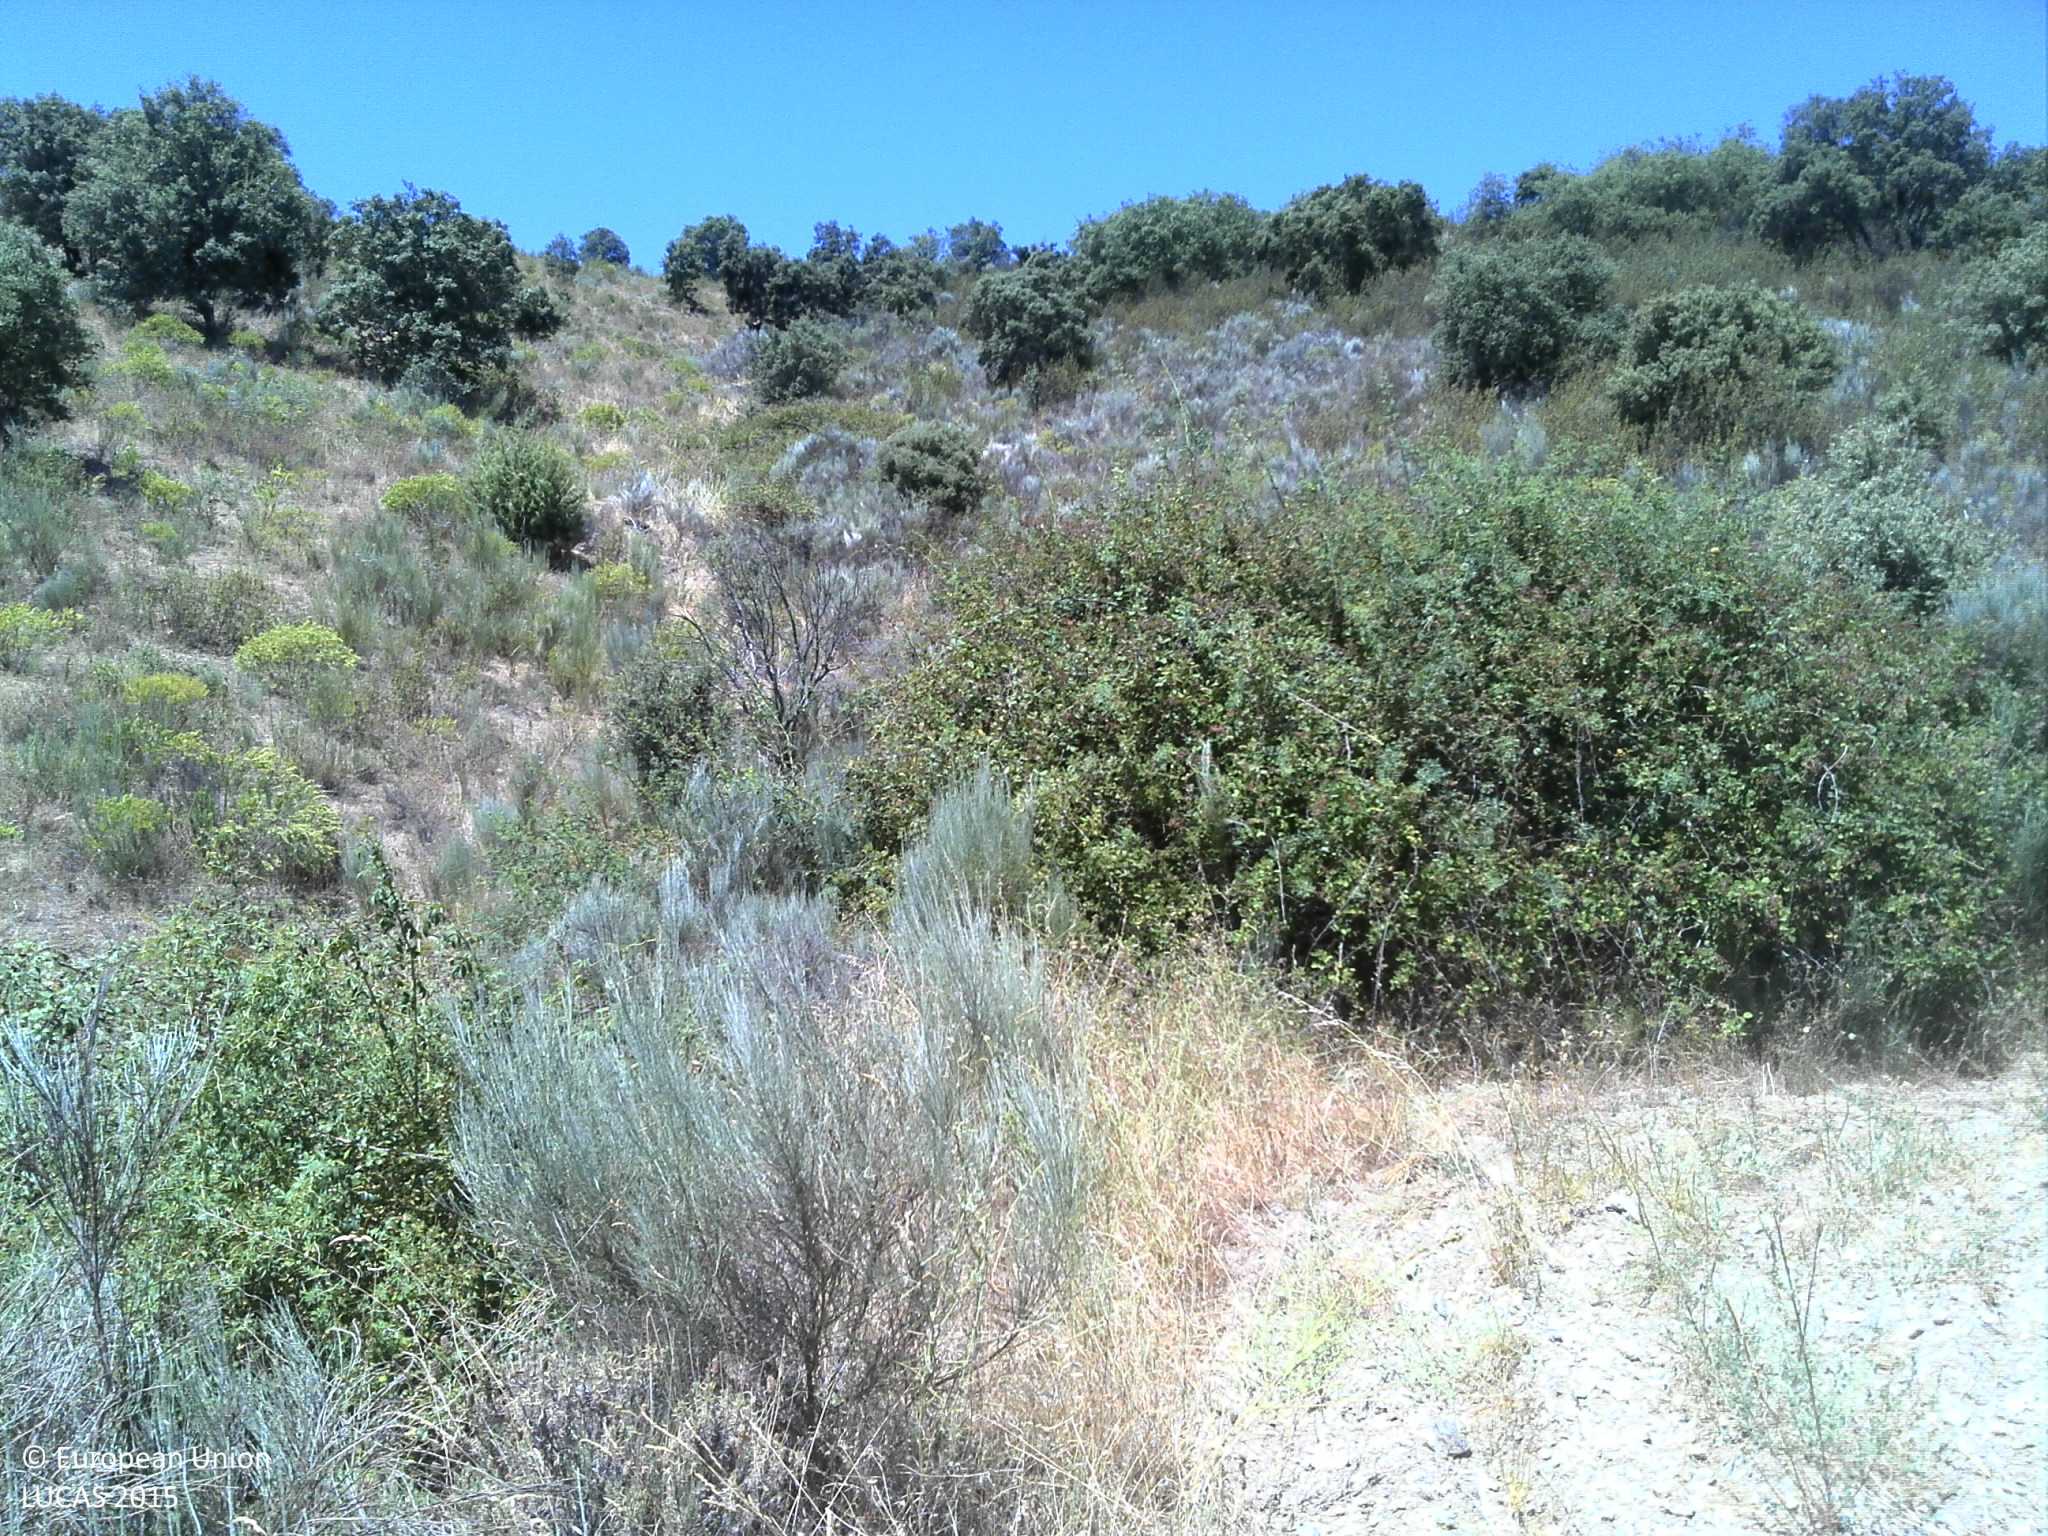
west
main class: Shrubland
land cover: Shrubland with sparse tree cover
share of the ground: > 75 %
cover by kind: shrubs 90 %, broadleaved forest trees 5 %, herbaceous plants 5 %
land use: Abandoned areas
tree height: > 5 m
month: July
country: PT
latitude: 41.3490
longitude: -7.1226
